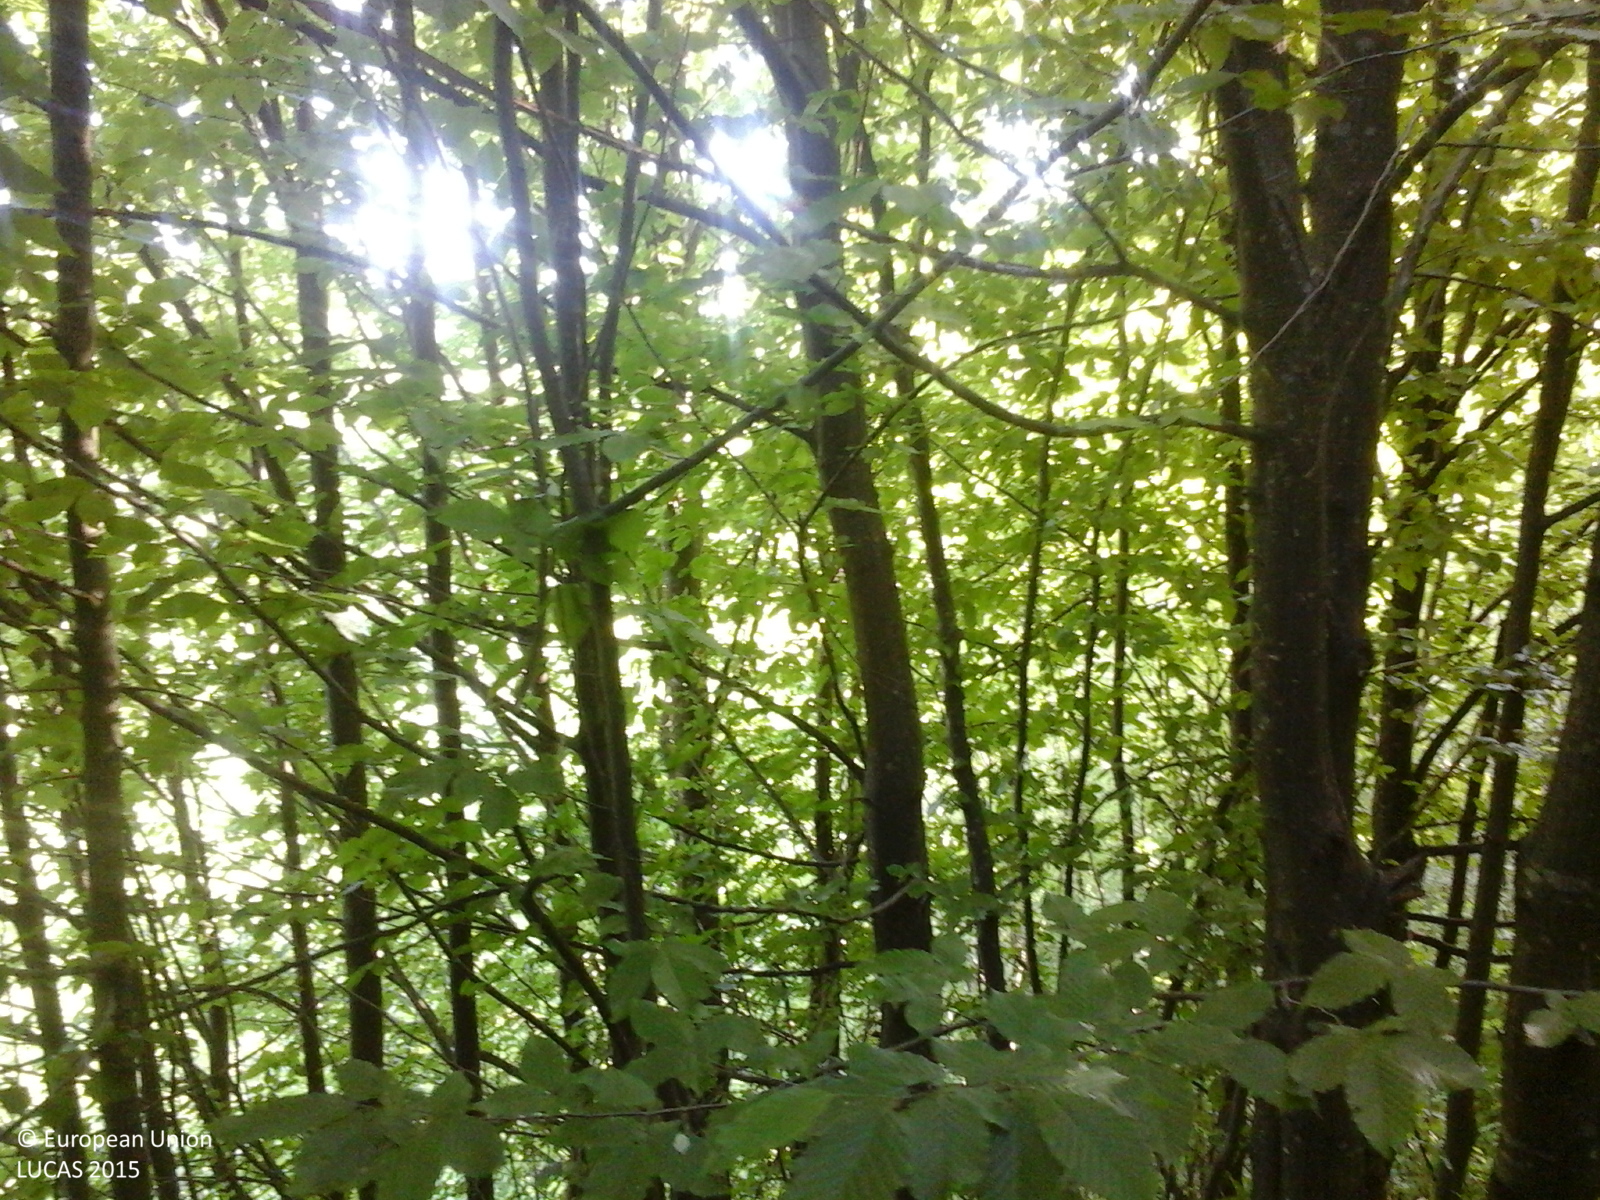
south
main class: Woodland
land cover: Broadleaved woodland
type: beech forest
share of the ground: > 75 %
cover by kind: broadleaved forest trees 100 %
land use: Forestry
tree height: > 5 m
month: June
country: RO
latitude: 45.1135
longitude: 25.6724
